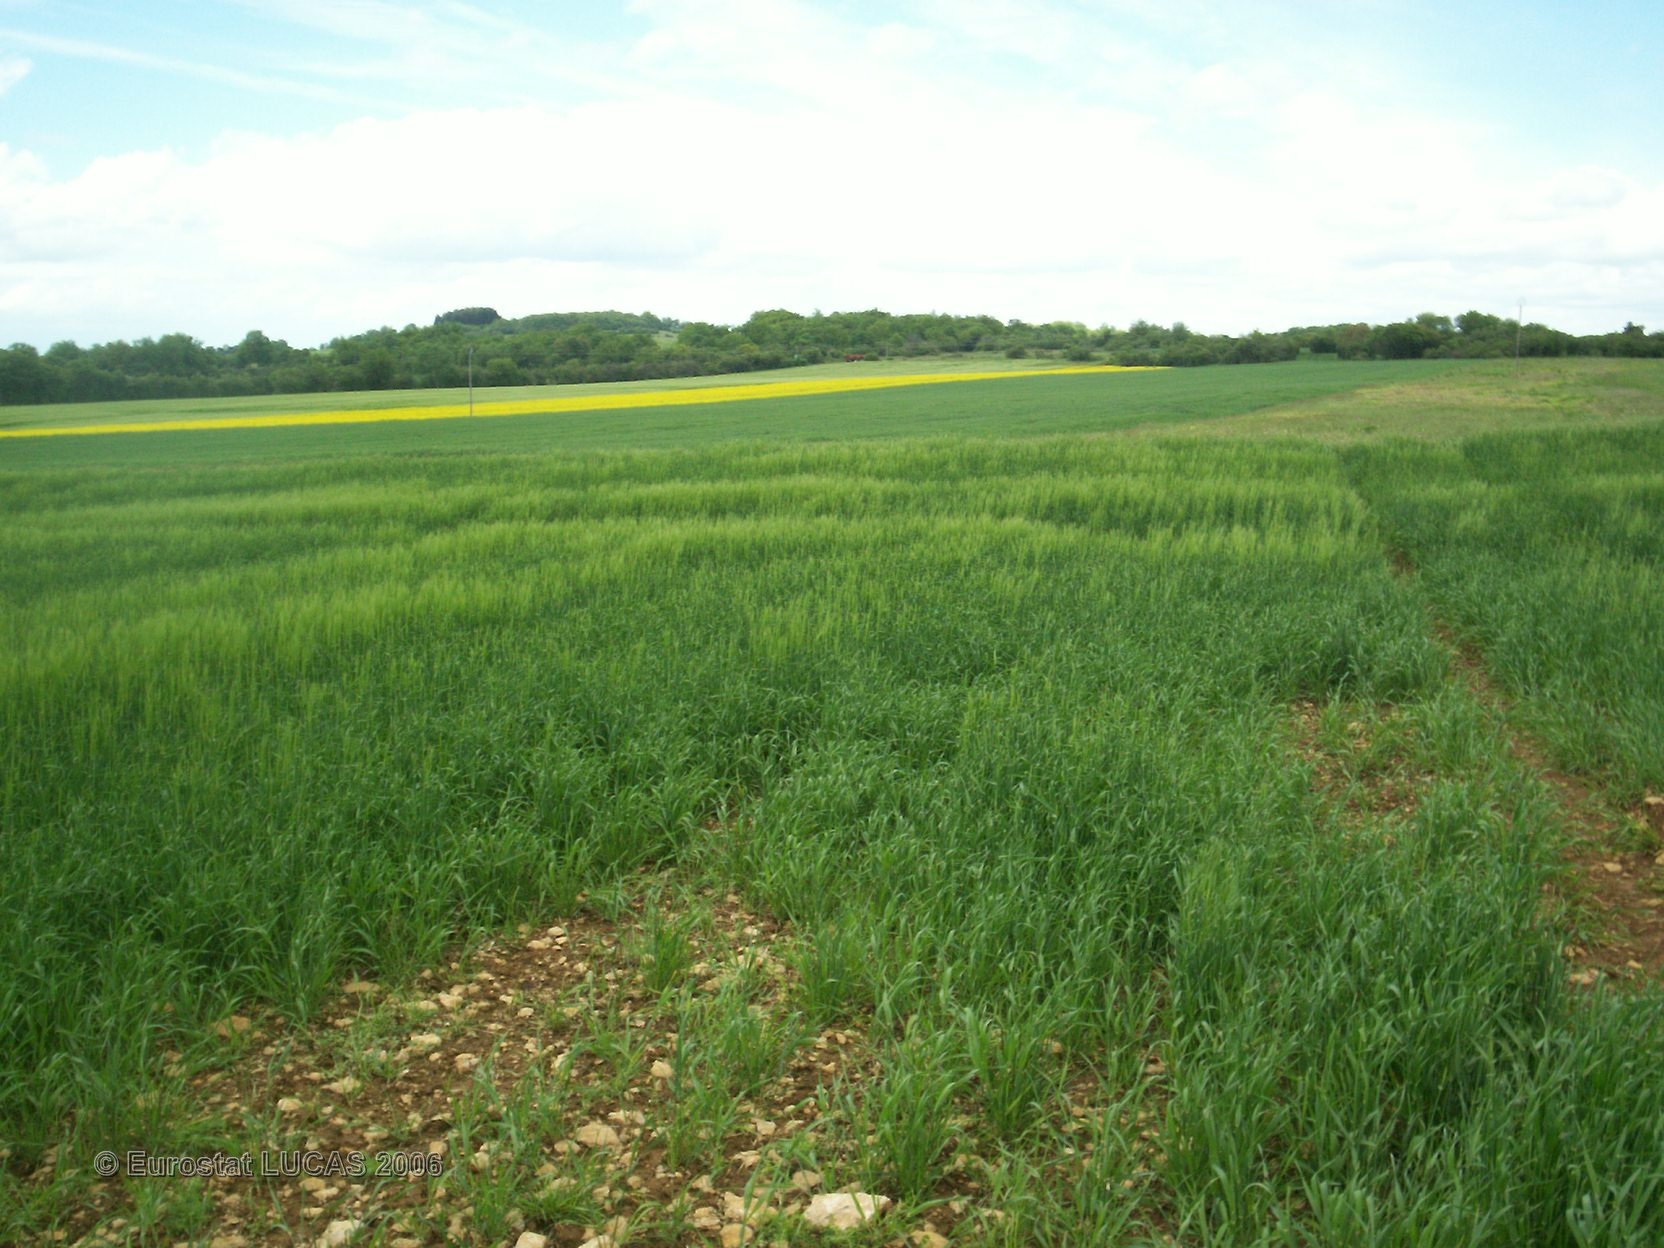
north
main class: Cropland
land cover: Barley
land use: Agriculture (excluding fallow land and kitchen gardens)
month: May
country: FR
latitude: 46.9740
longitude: 4.6243
